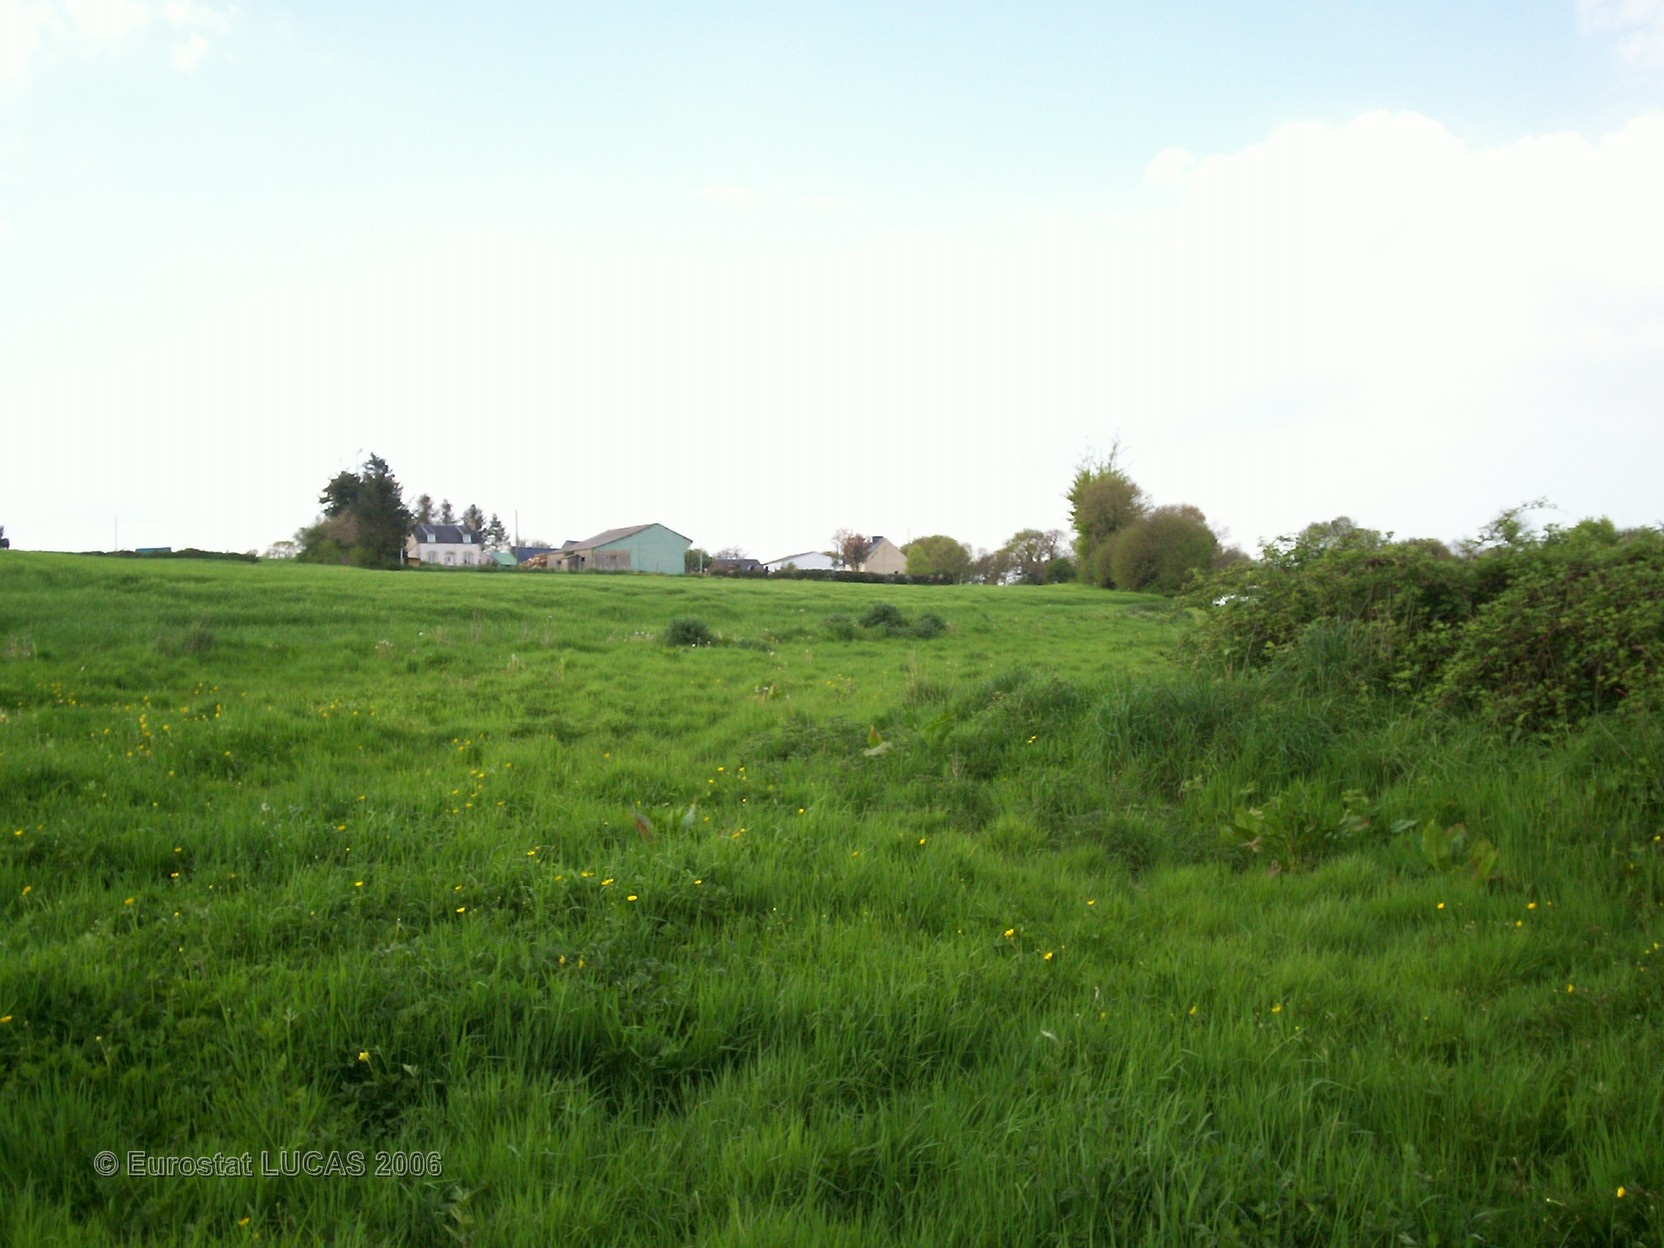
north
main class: Grassland
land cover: Grassland without tree/shrub cover
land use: Agriculture (excluding fallow land and kitchen gardens)
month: May
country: FR
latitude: 48.4295
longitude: -3.6368
